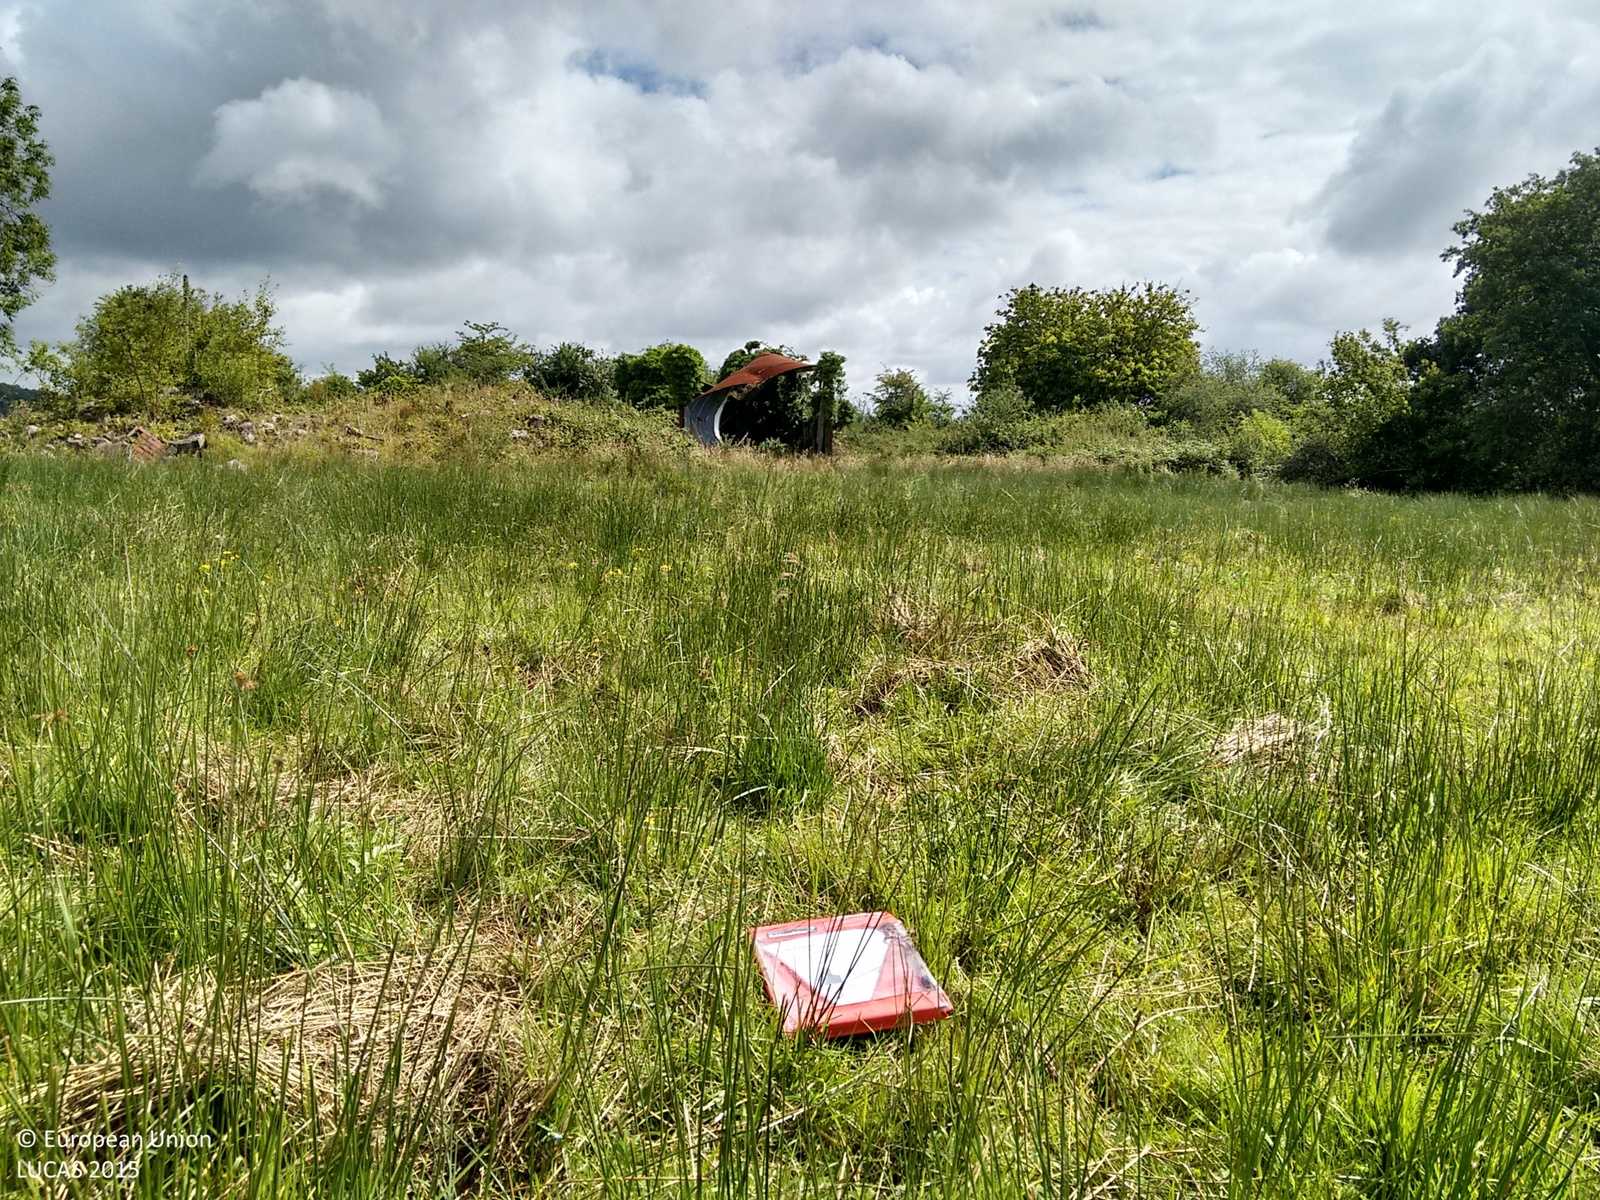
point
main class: Grassland
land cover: Grassland without tree/shrub cover
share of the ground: > 75 %
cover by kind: herbaceous plants 100 %
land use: Agriculture (excluding fallow land and kitchen gardens)
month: July
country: GB
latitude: 51.8086
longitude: -4.0632
